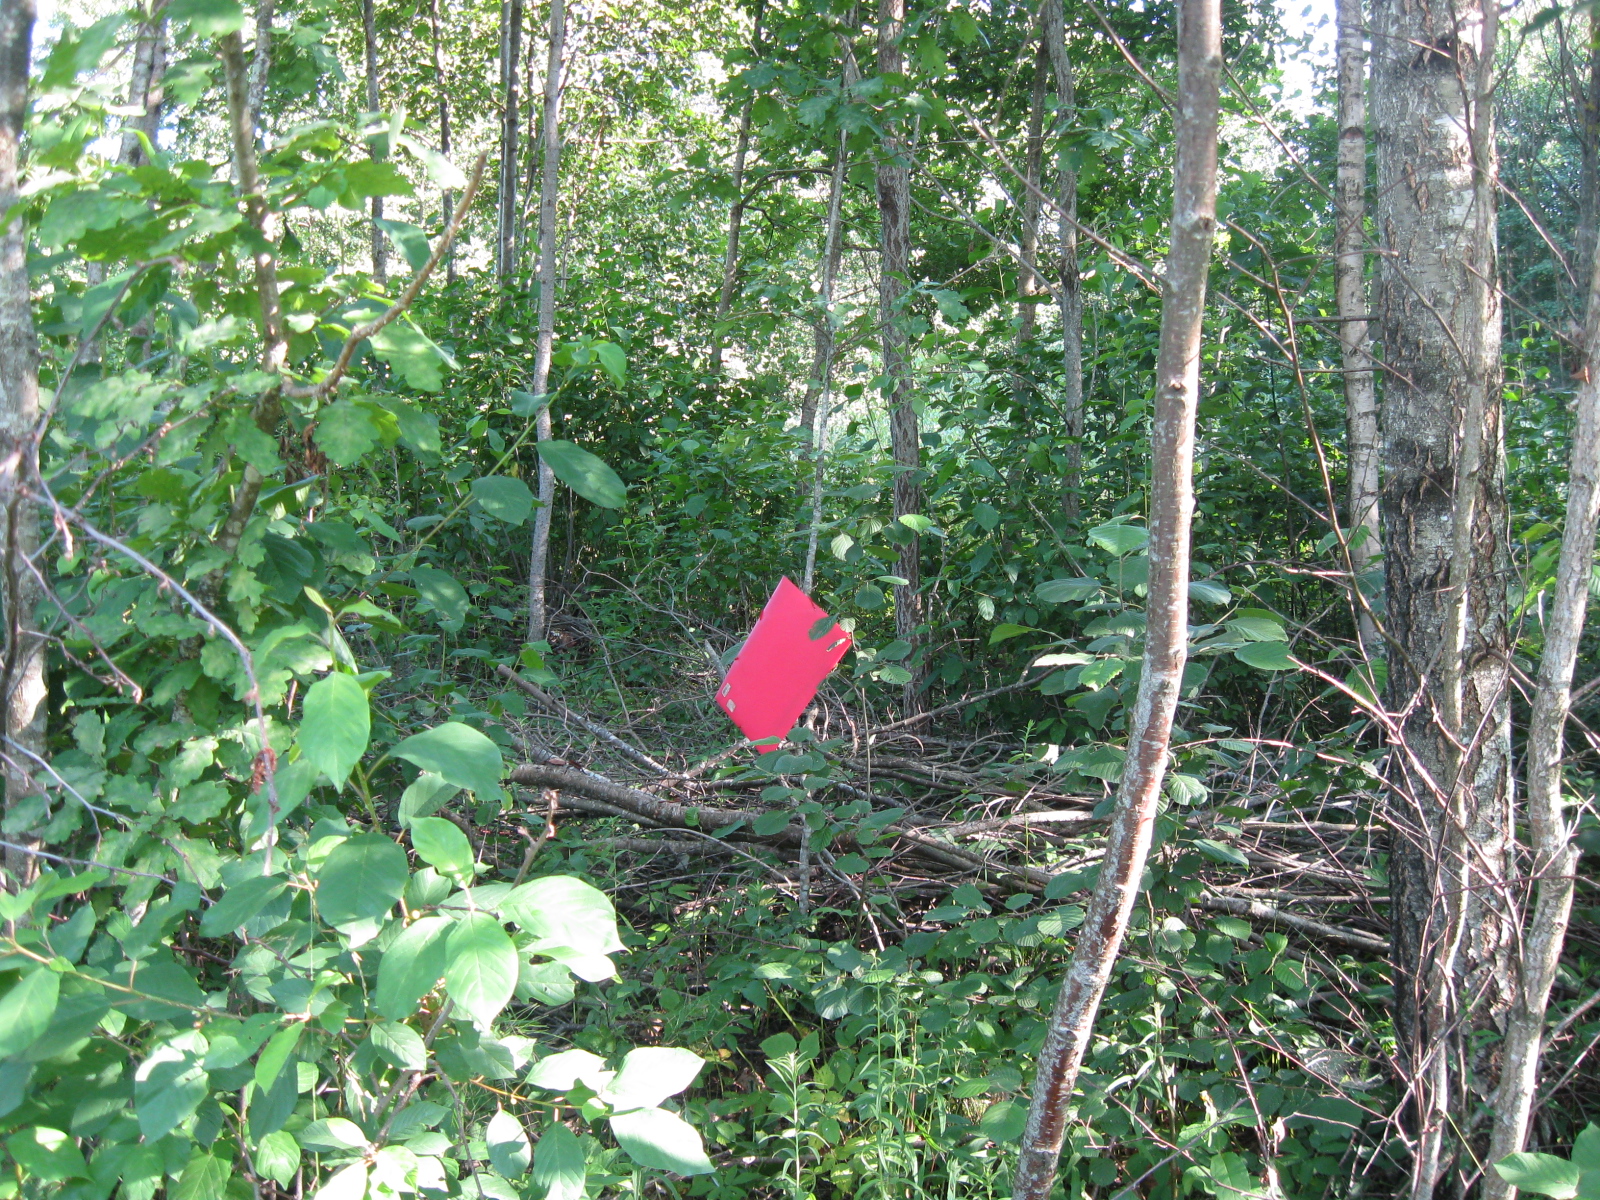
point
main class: Woodland
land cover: Broadleaved woodland
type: non-riverine alder, birch or aspen forest
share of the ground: > 75 %
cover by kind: broadleaved forest trees 90 %, herbaceous plants 10 %
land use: Forestry
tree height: > 5 m
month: July
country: LT
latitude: 54.4936
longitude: 24.3814
